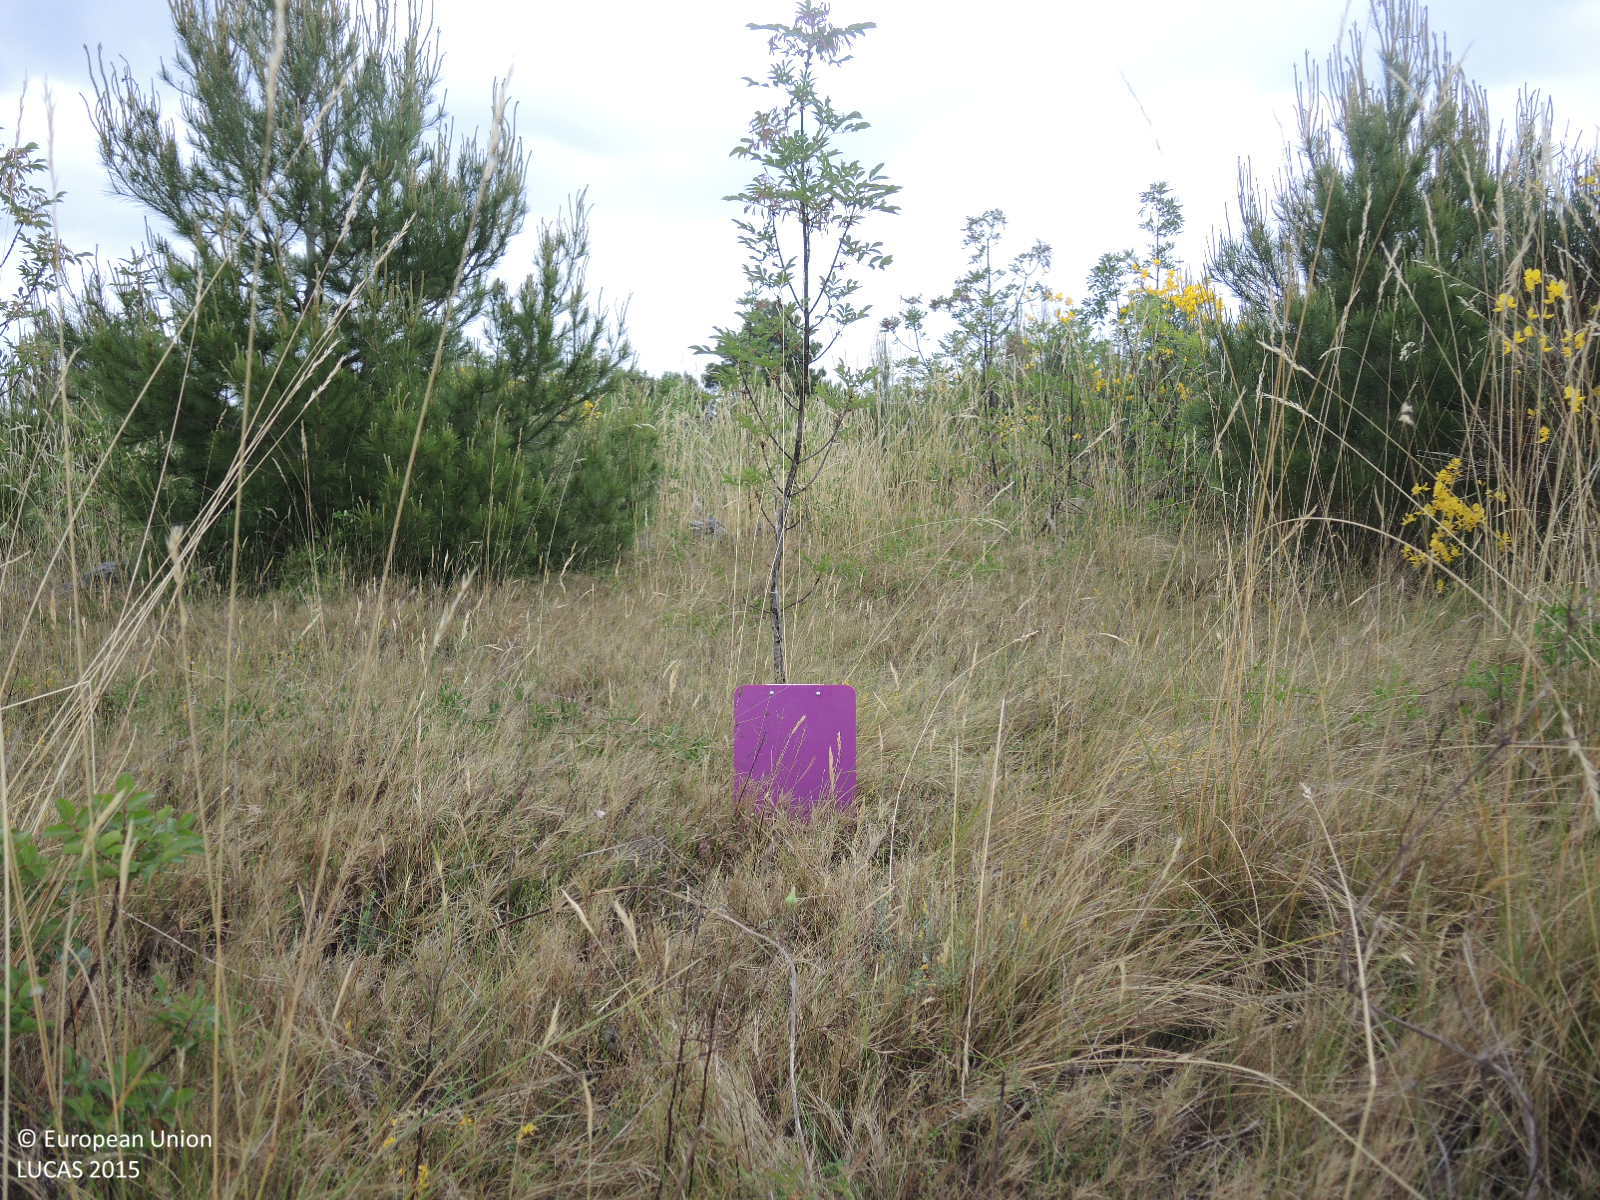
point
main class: Woodland
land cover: Pine dominated coniferous woodland
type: coniferous forest of the mediterranean region
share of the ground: 10 - 25 %
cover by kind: herbaceous plants 60 %, shrubs 20 %, coniferous forest trees 15 %, unconsolidated bare surface 5 %
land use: Semi-natural and natural areas not in use
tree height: < 5 m
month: May
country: HR
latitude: 43.7341
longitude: 15.8387
